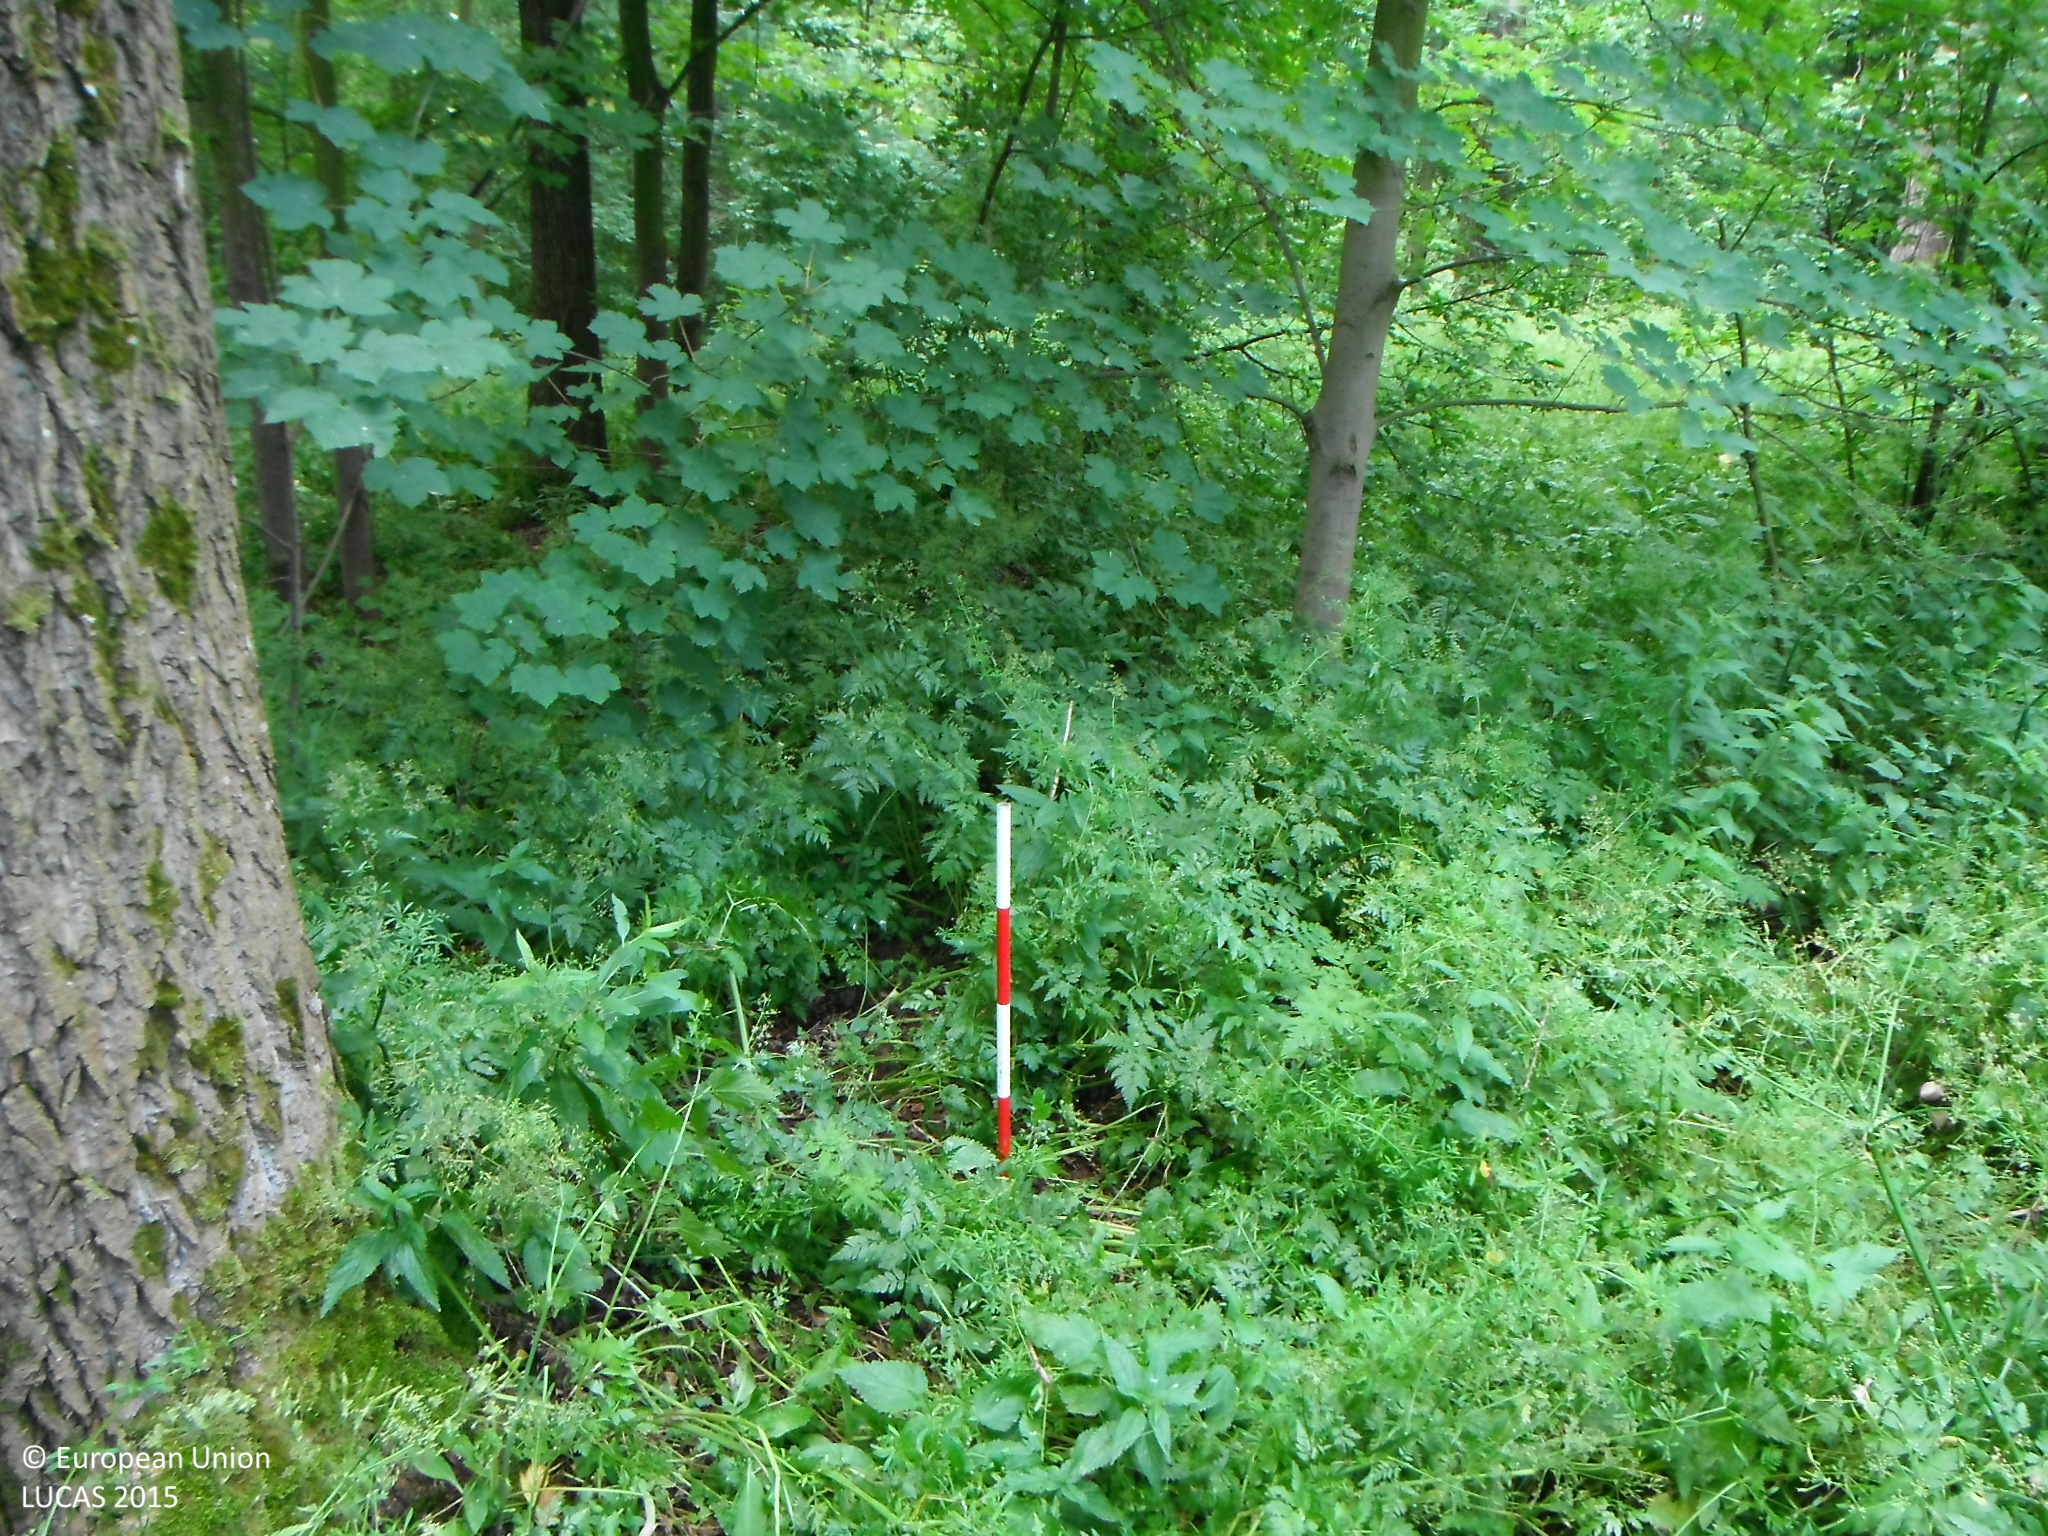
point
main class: Woodland
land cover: Broadleaved woodland
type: floodplain forest
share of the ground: > 75 %
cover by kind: broadleaved forest trees 75 %, herbaceous plants 25 %
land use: Forestry
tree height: > 5 m
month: July
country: SK
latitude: 49.4224
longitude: 19.5254
